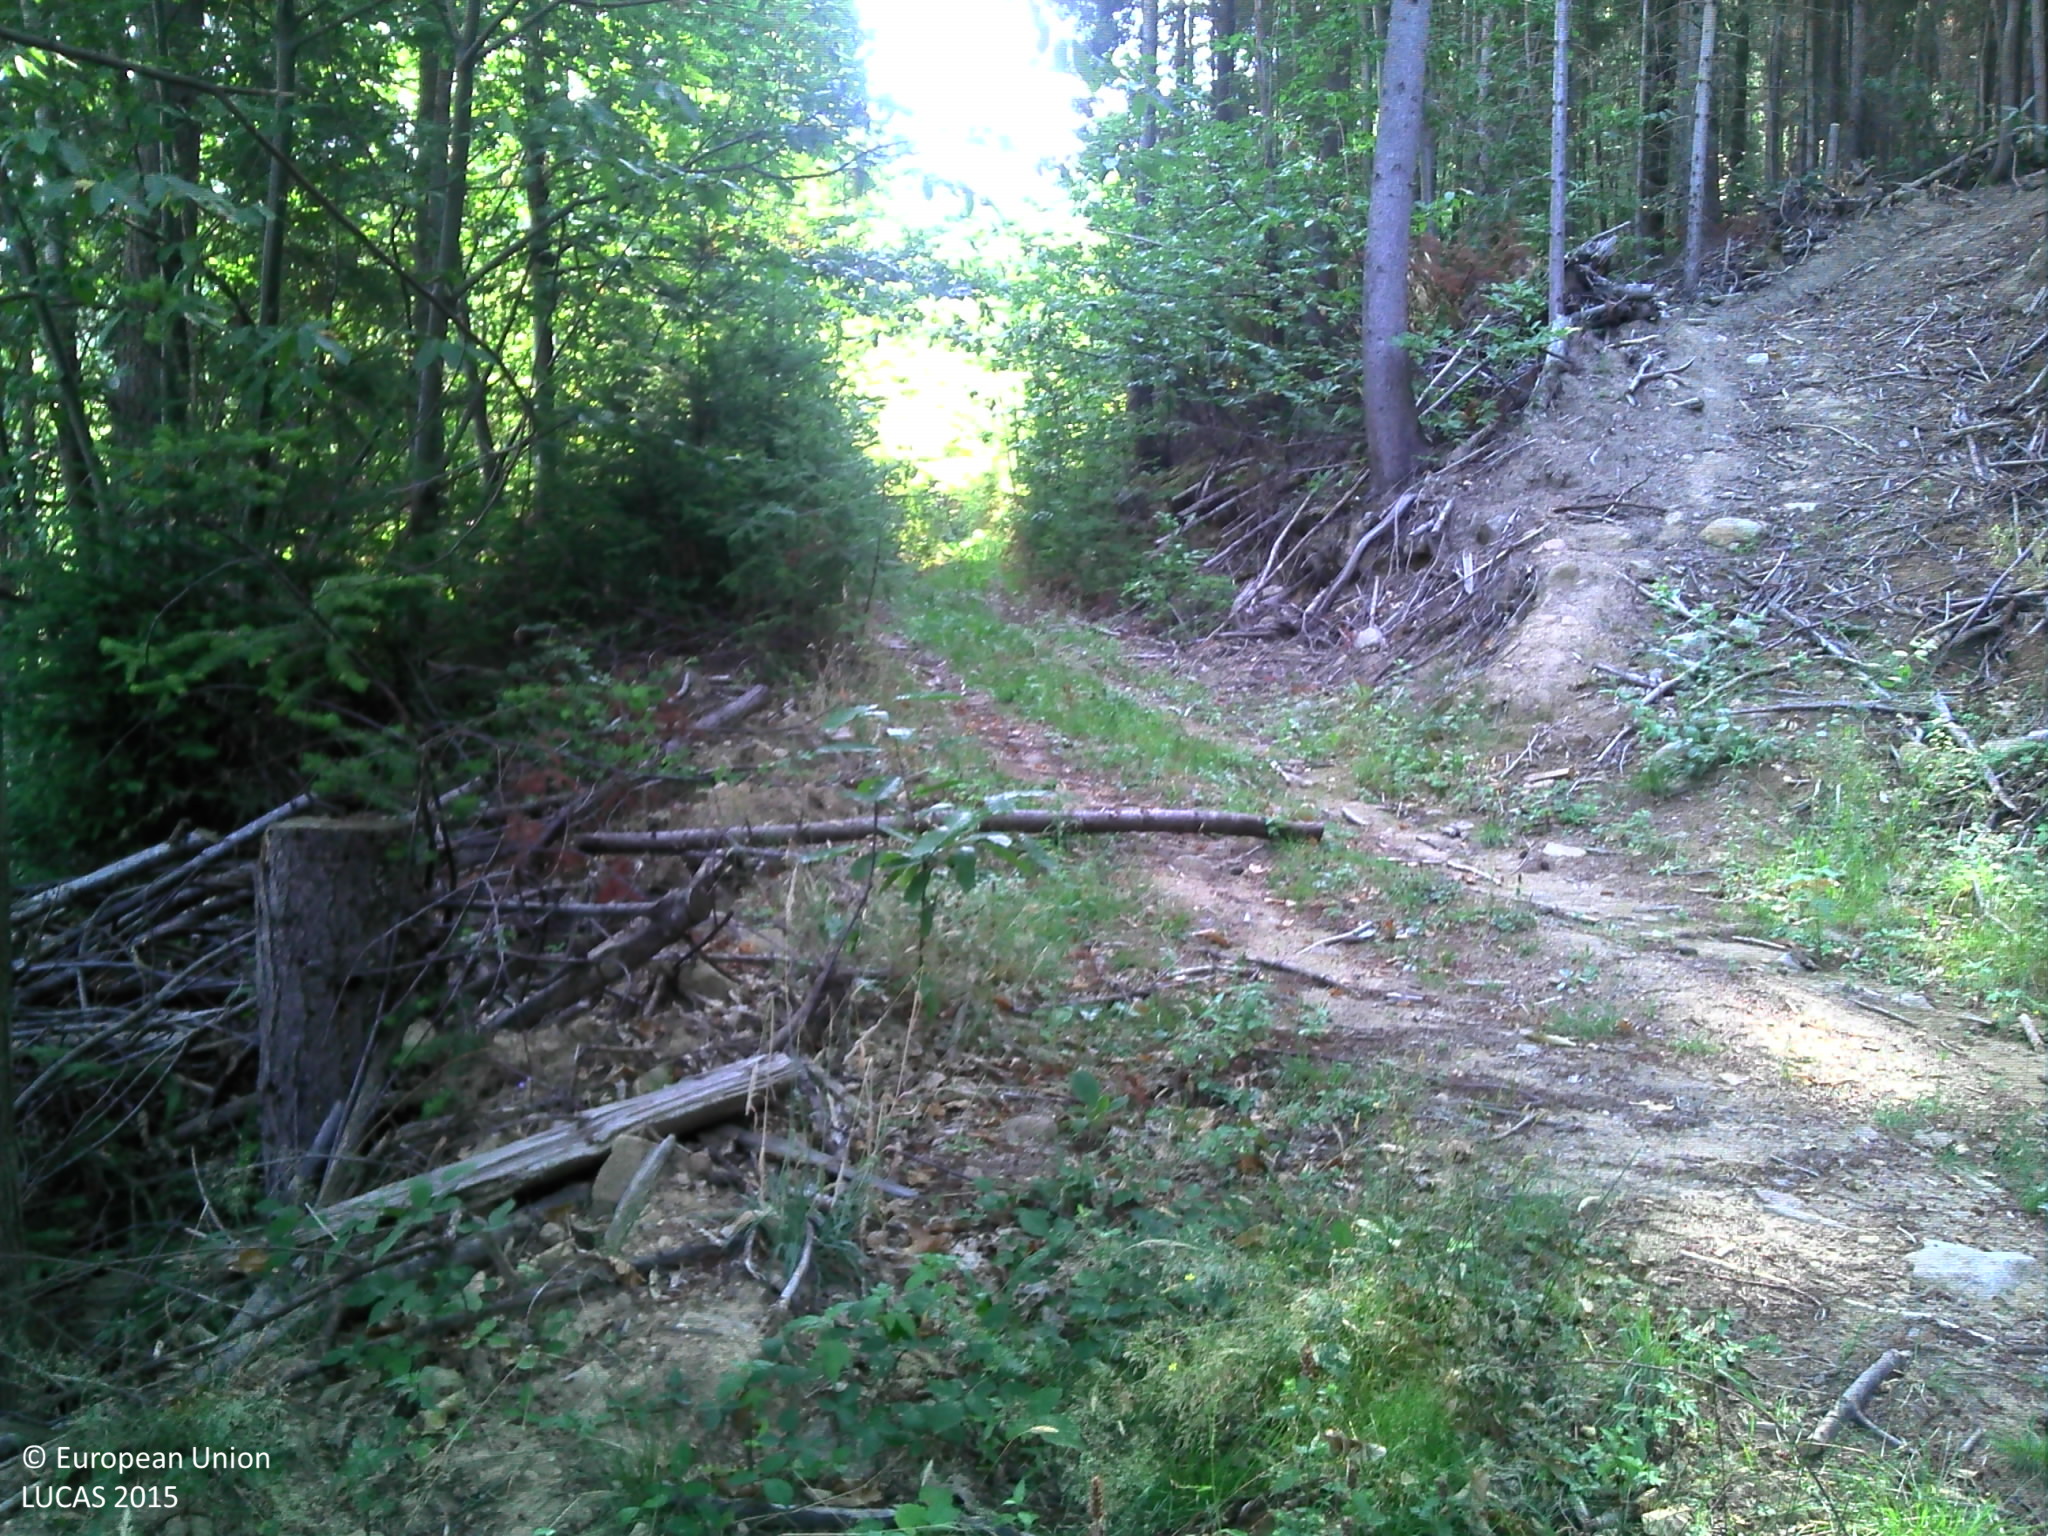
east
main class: Woodland
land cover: Spruce dominated mixed woodland
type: alpine coniferous forest
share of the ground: > 75 %
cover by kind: coniferous forest trees 50 %, broadleaved forest trees 25 %, herbaceous plants 25 %
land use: Forestry
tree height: > 5 m
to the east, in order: Spruce dominated mixed woodland; Pine dominated mixed woodland; Tracks; Spruce dominated coniferous woodland
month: August
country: FR
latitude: 45.0609
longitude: 4.6333
